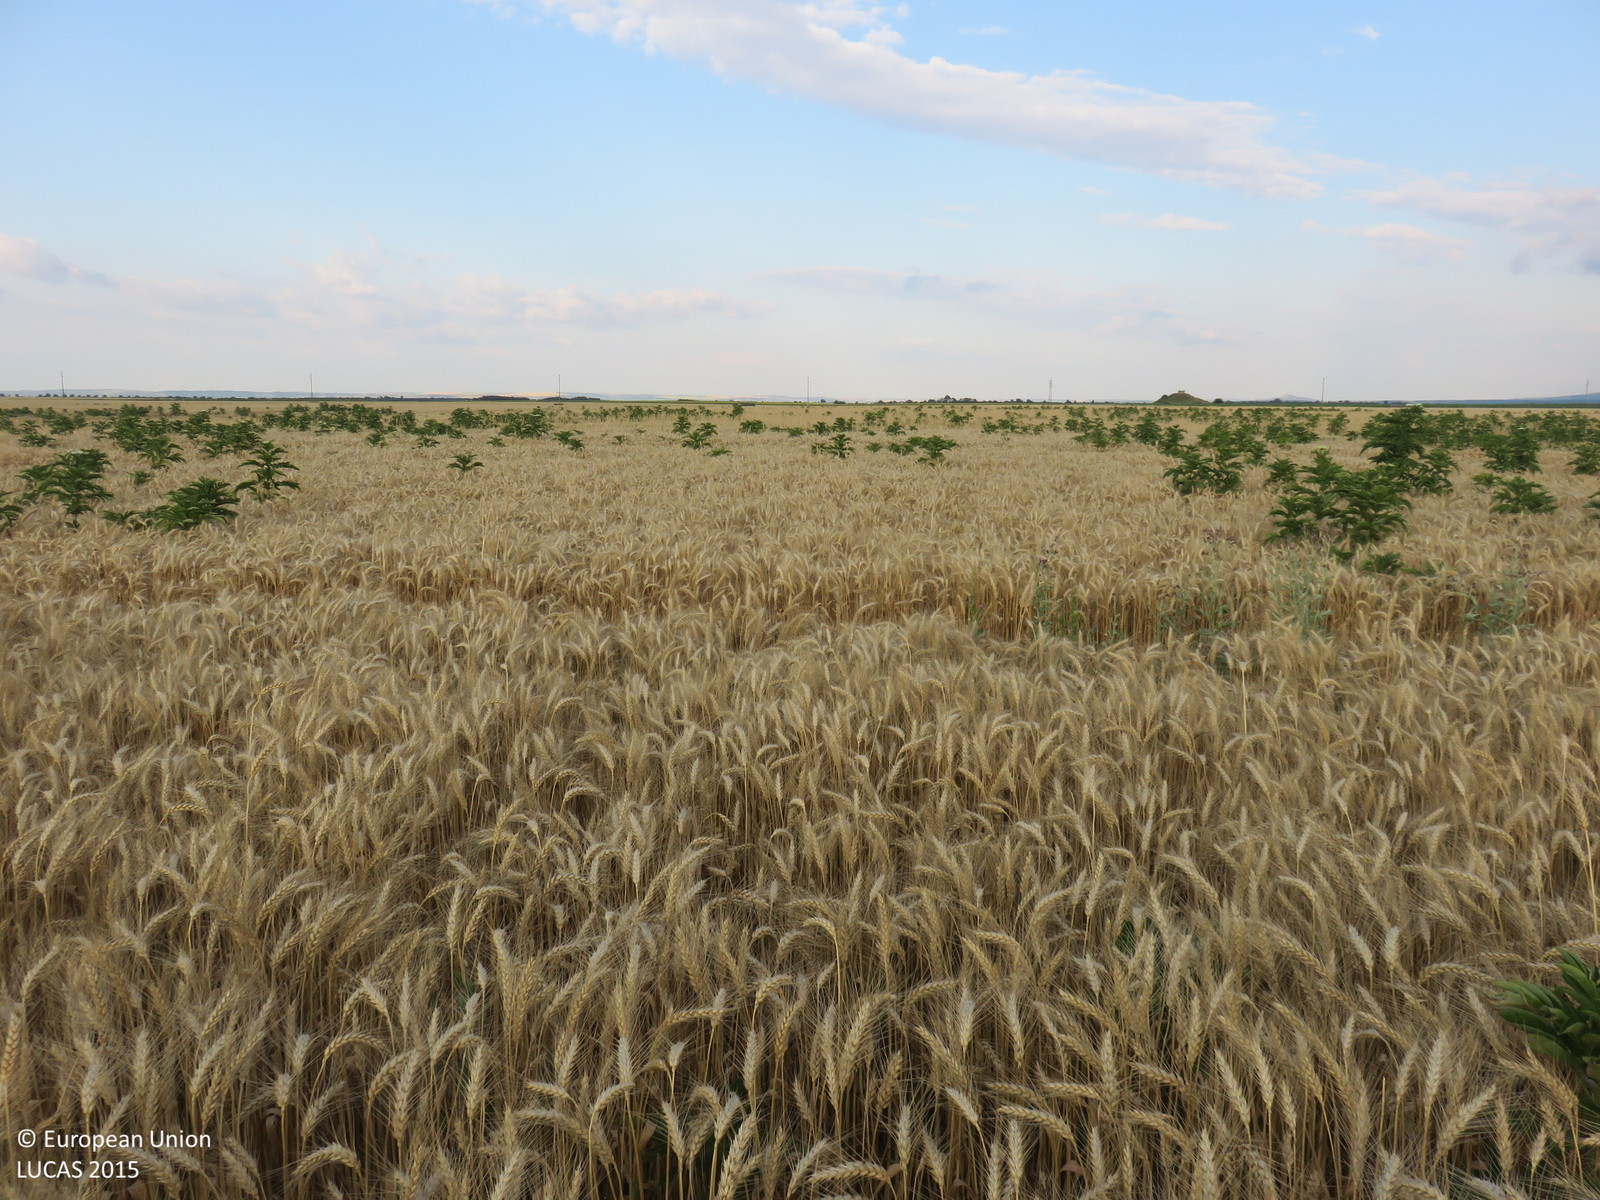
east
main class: Cropland
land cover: Common wheat
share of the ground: > 75 %
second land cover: Spontaneously vegetated surfaces
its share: < 10 %
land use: Agriculture (excluding fallow land and kitchen gardens)
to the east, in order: Common wheat; Spontaneously vegetated surfaces
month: June
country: BG
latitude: 43.3505
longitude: 24.9597
